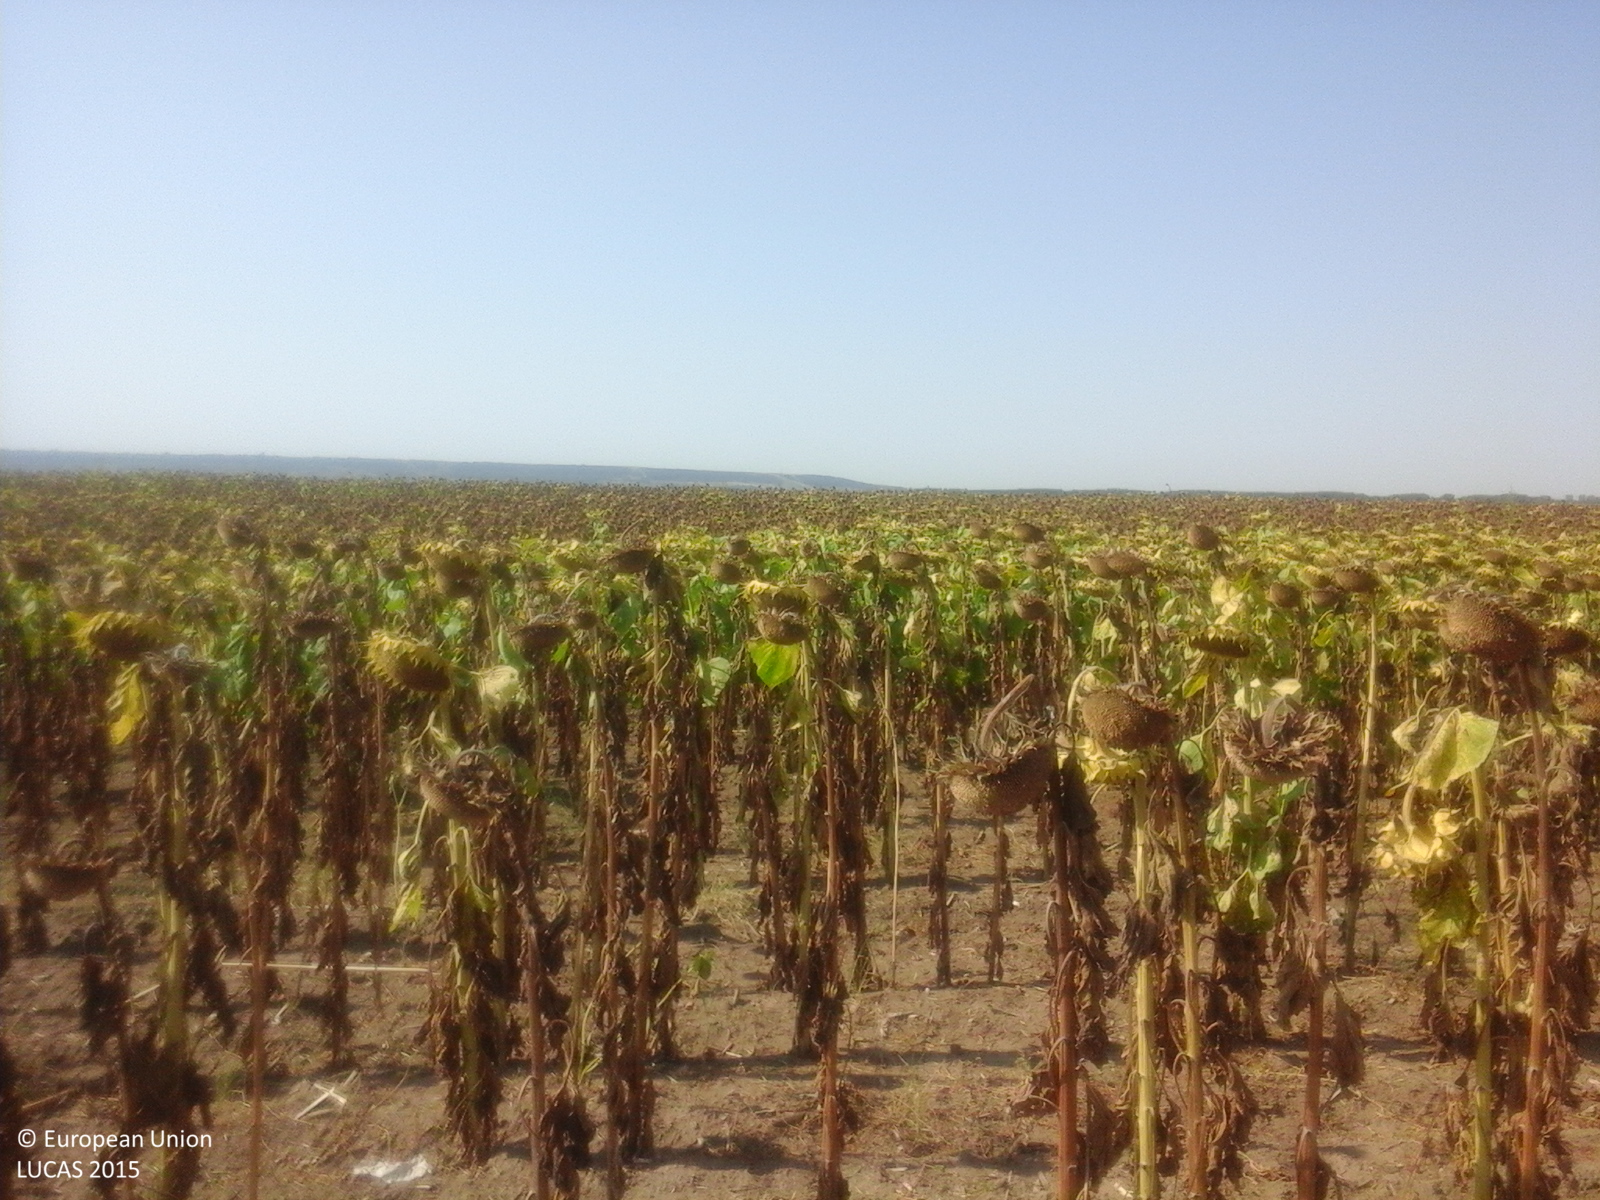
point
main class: Cropland
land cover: Sunflower
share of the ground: > 75 %
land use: Agriculture (excluding fallow land and kitchen gardens)
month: August
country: RO
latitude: 43.8416
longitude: 23.5434
